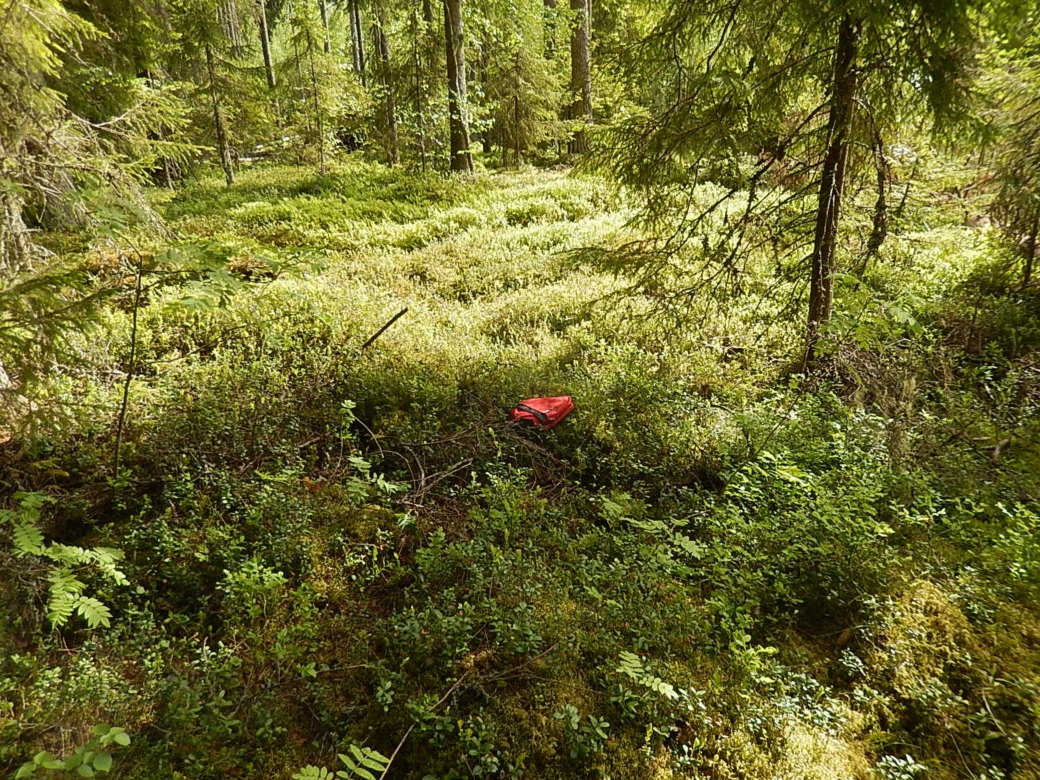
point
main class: Woodland
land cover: Spruce dominated coniferous woodland
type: boreal forest
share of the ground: > 75 %
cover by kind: coniferous forest trees 75 %, shrubs 15 %, broadleaved forest trees 10 %
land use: Forestry
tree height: > 5 m
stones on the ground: < 10 %
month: June
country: FI
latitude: 61.7944
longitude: 21.6383
